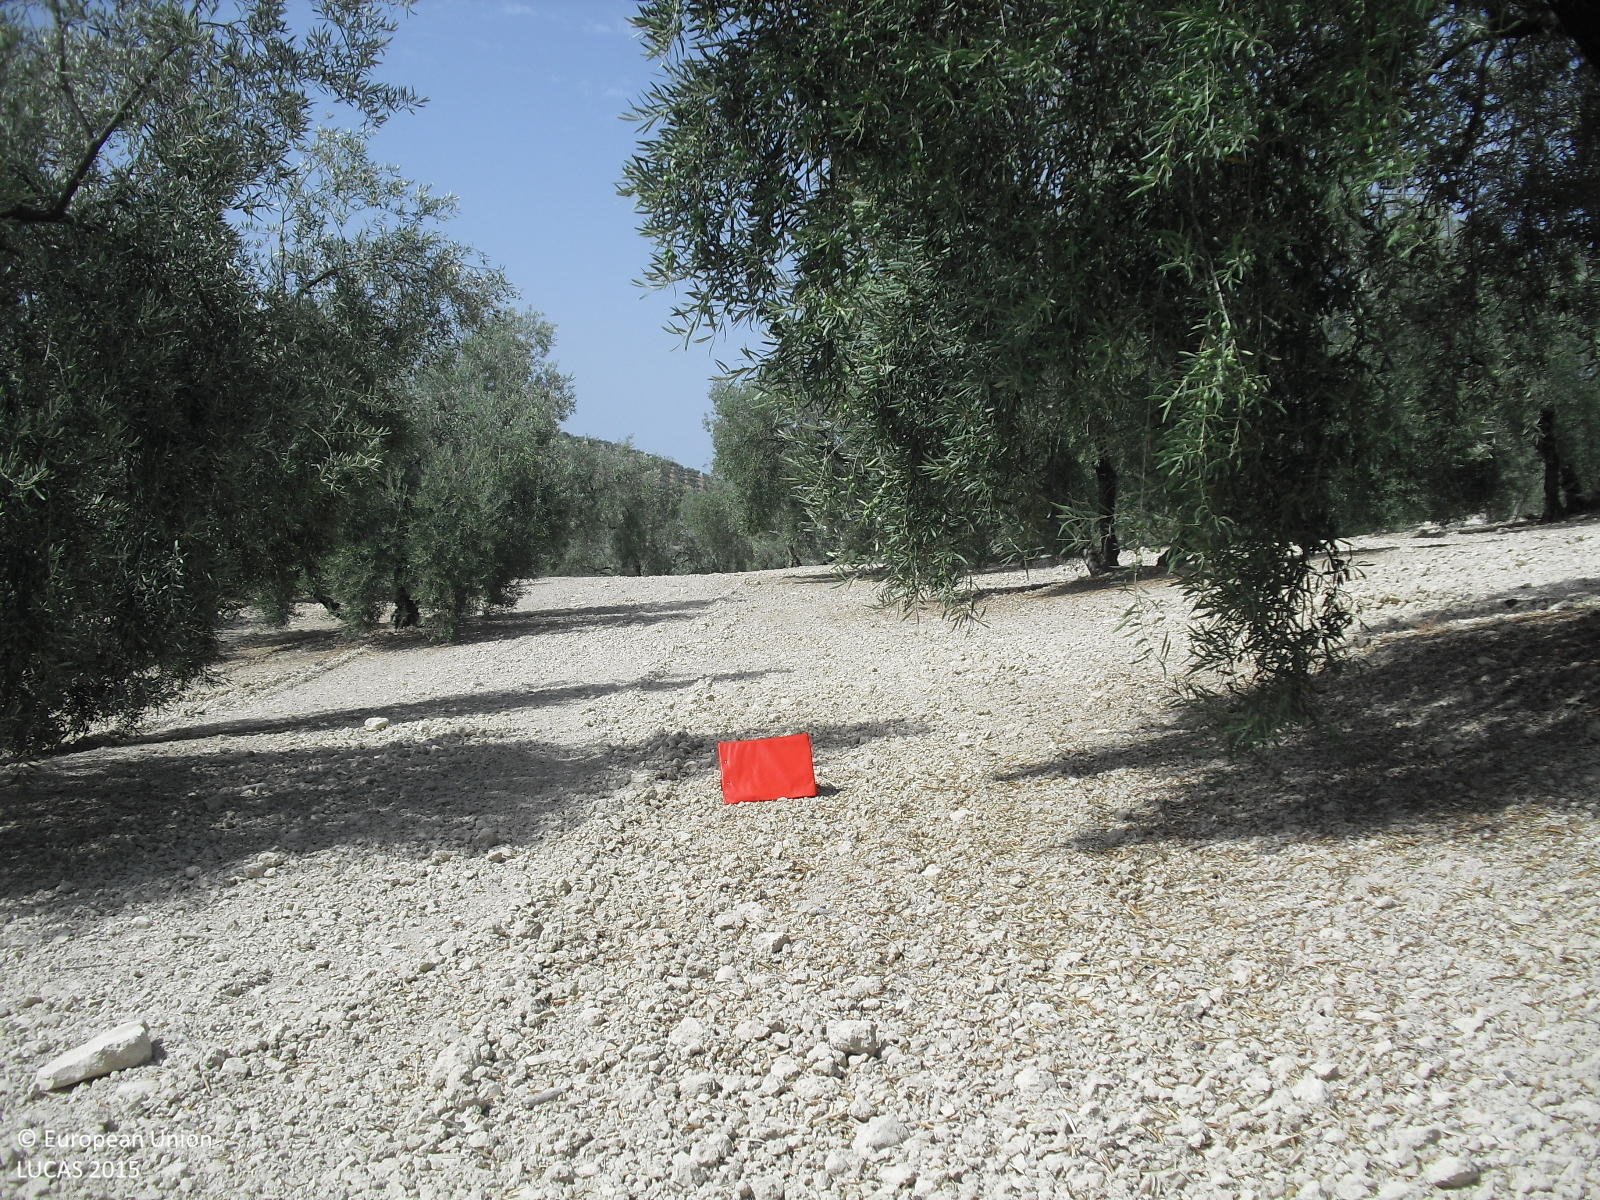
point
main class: Cropland
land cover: Olive groves
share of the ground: 25 - 50 %
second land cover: Other bare soil
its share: > 75 %
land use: Agriculture (excluding fallow land and kitchen gardens)
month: July
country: ES
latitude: 37.1602
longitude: -4.3997
